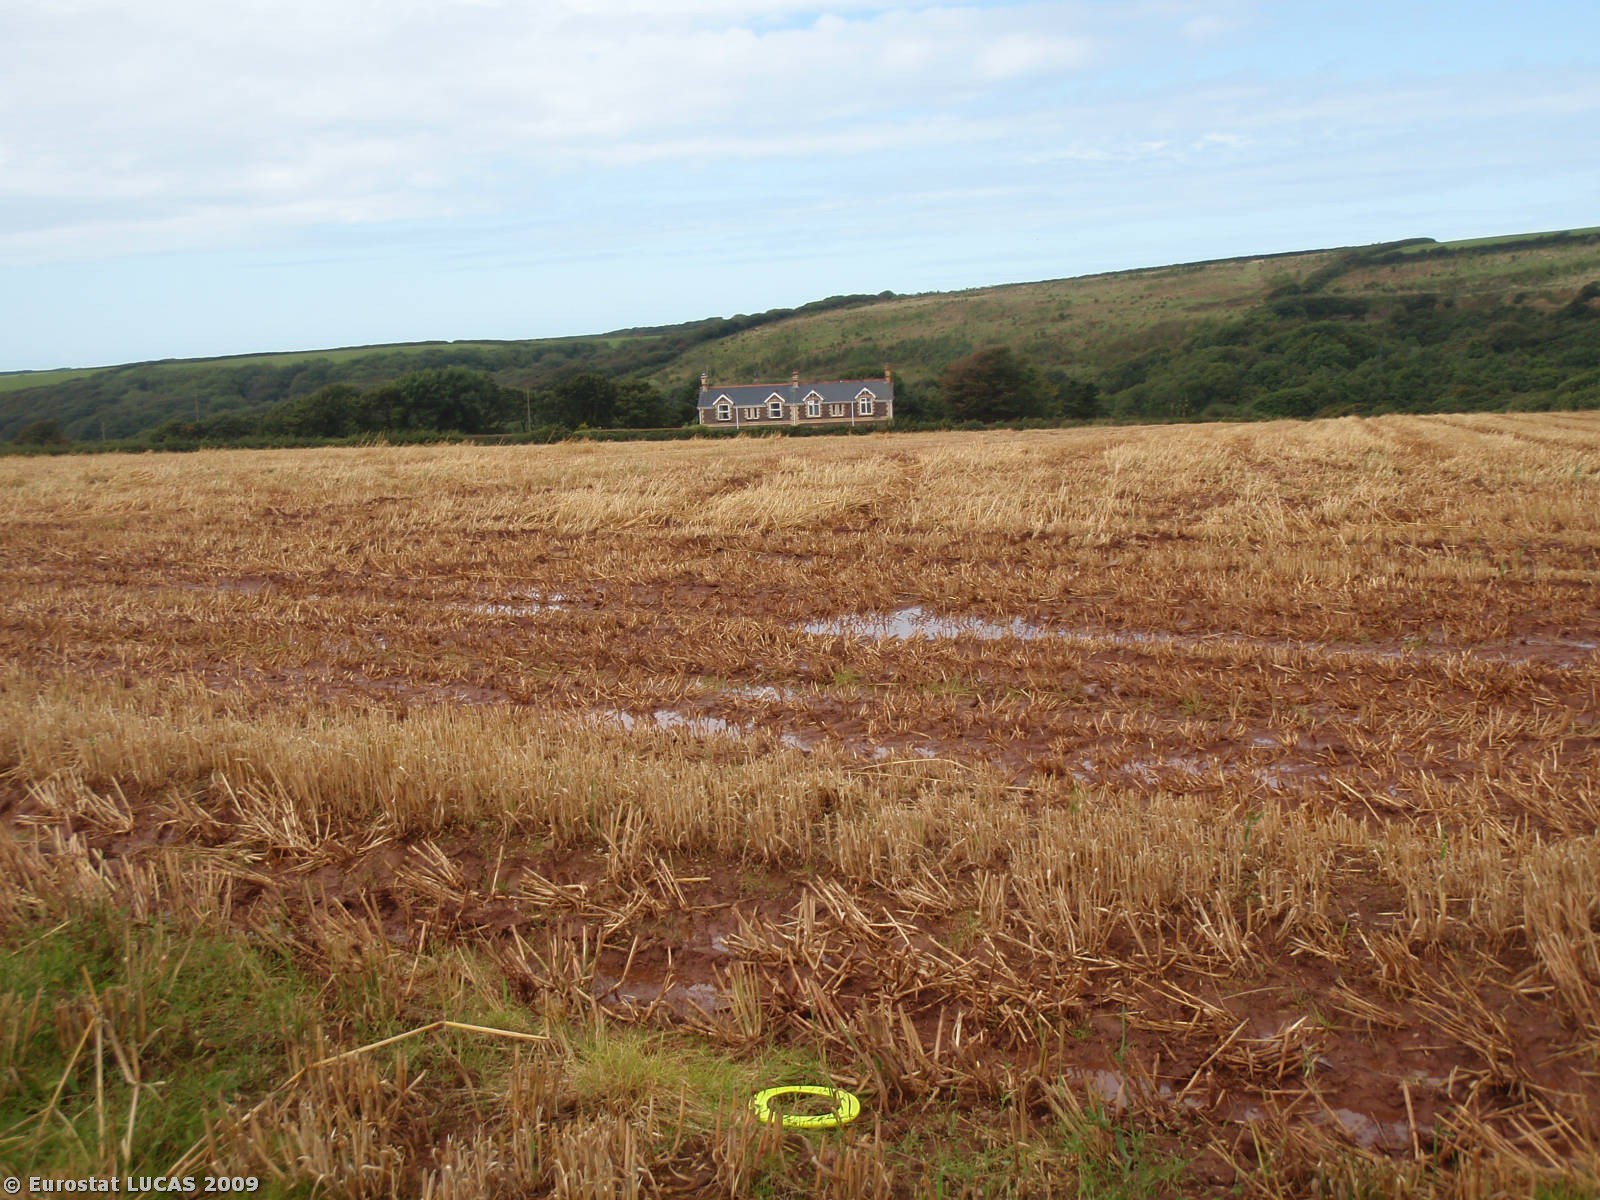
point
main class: Cropland
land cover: Oats
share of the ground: < 10 %
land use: Agriculture (excluding fallow land and kitchen gardens)
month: August
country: GB
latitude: 50.9933
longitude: -4.4513
